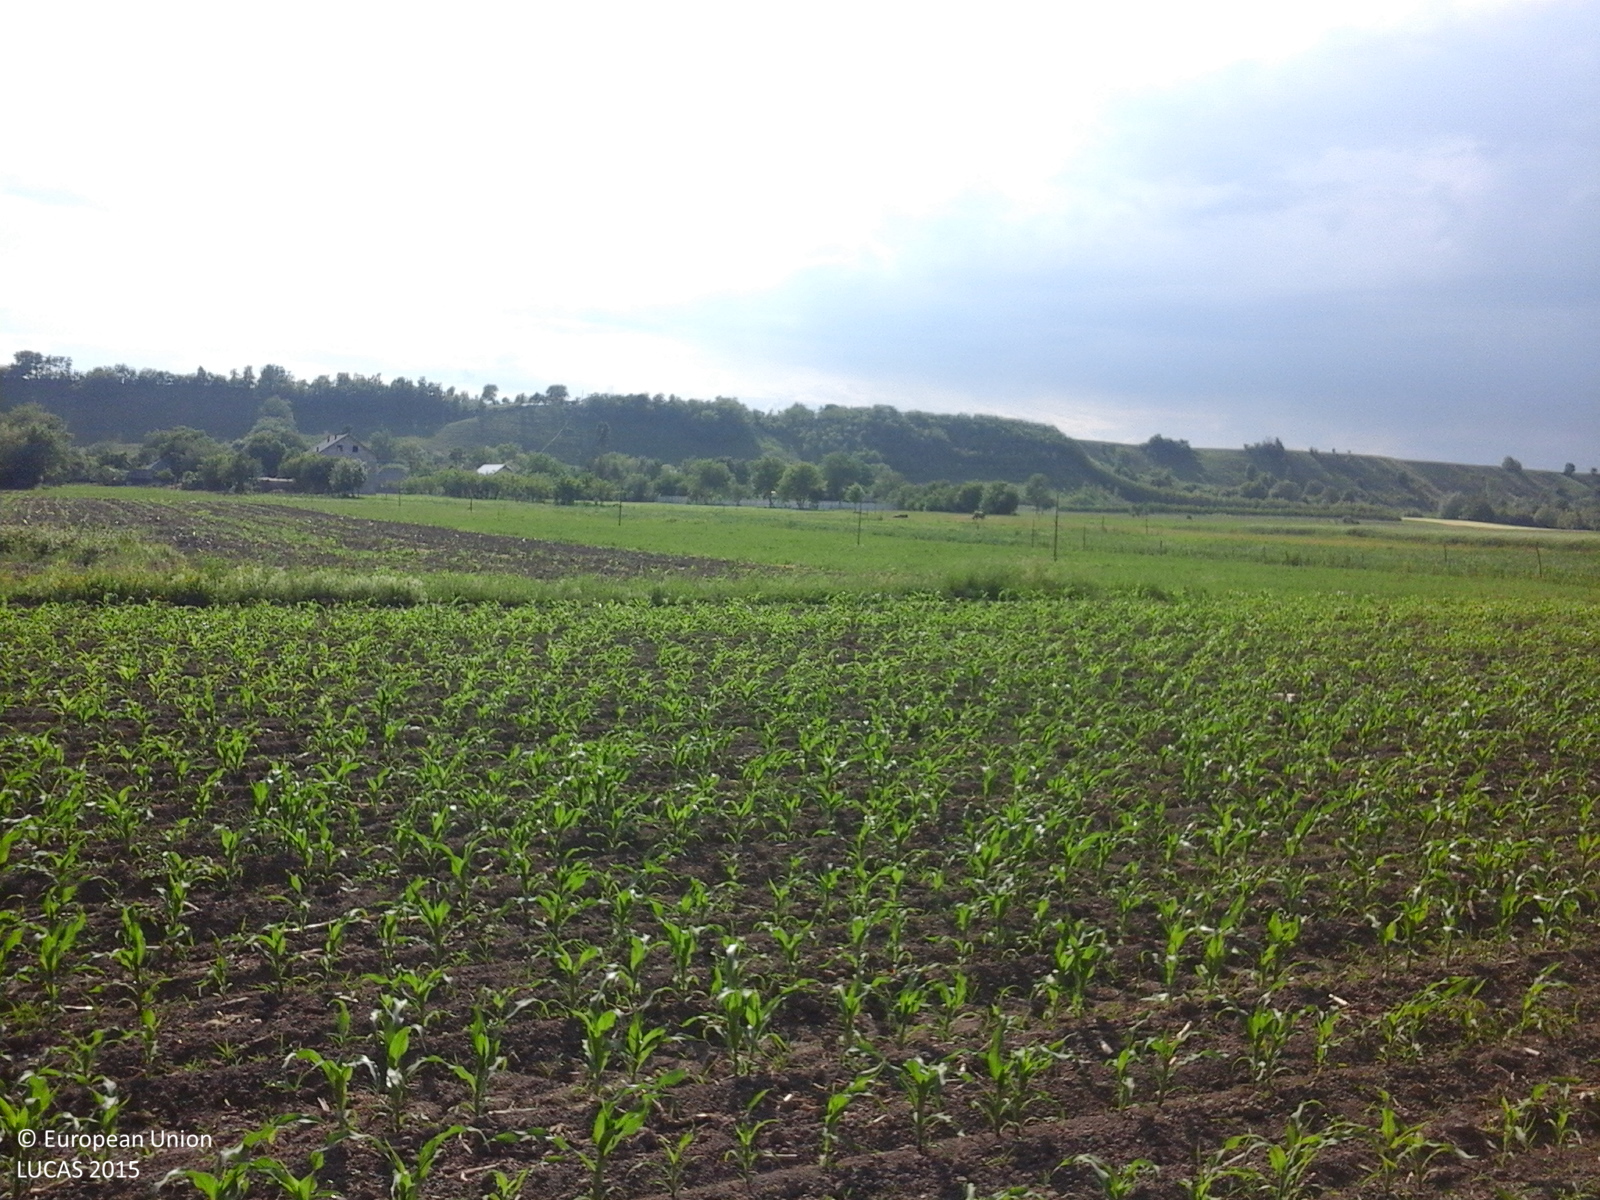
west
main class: Cropland
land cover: Maize
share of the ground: 10 - 25 %
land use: Agriculture (excluding fallow land and kitchen gardens)
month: June
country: RO
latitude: 46.7736
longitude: 26.5739
